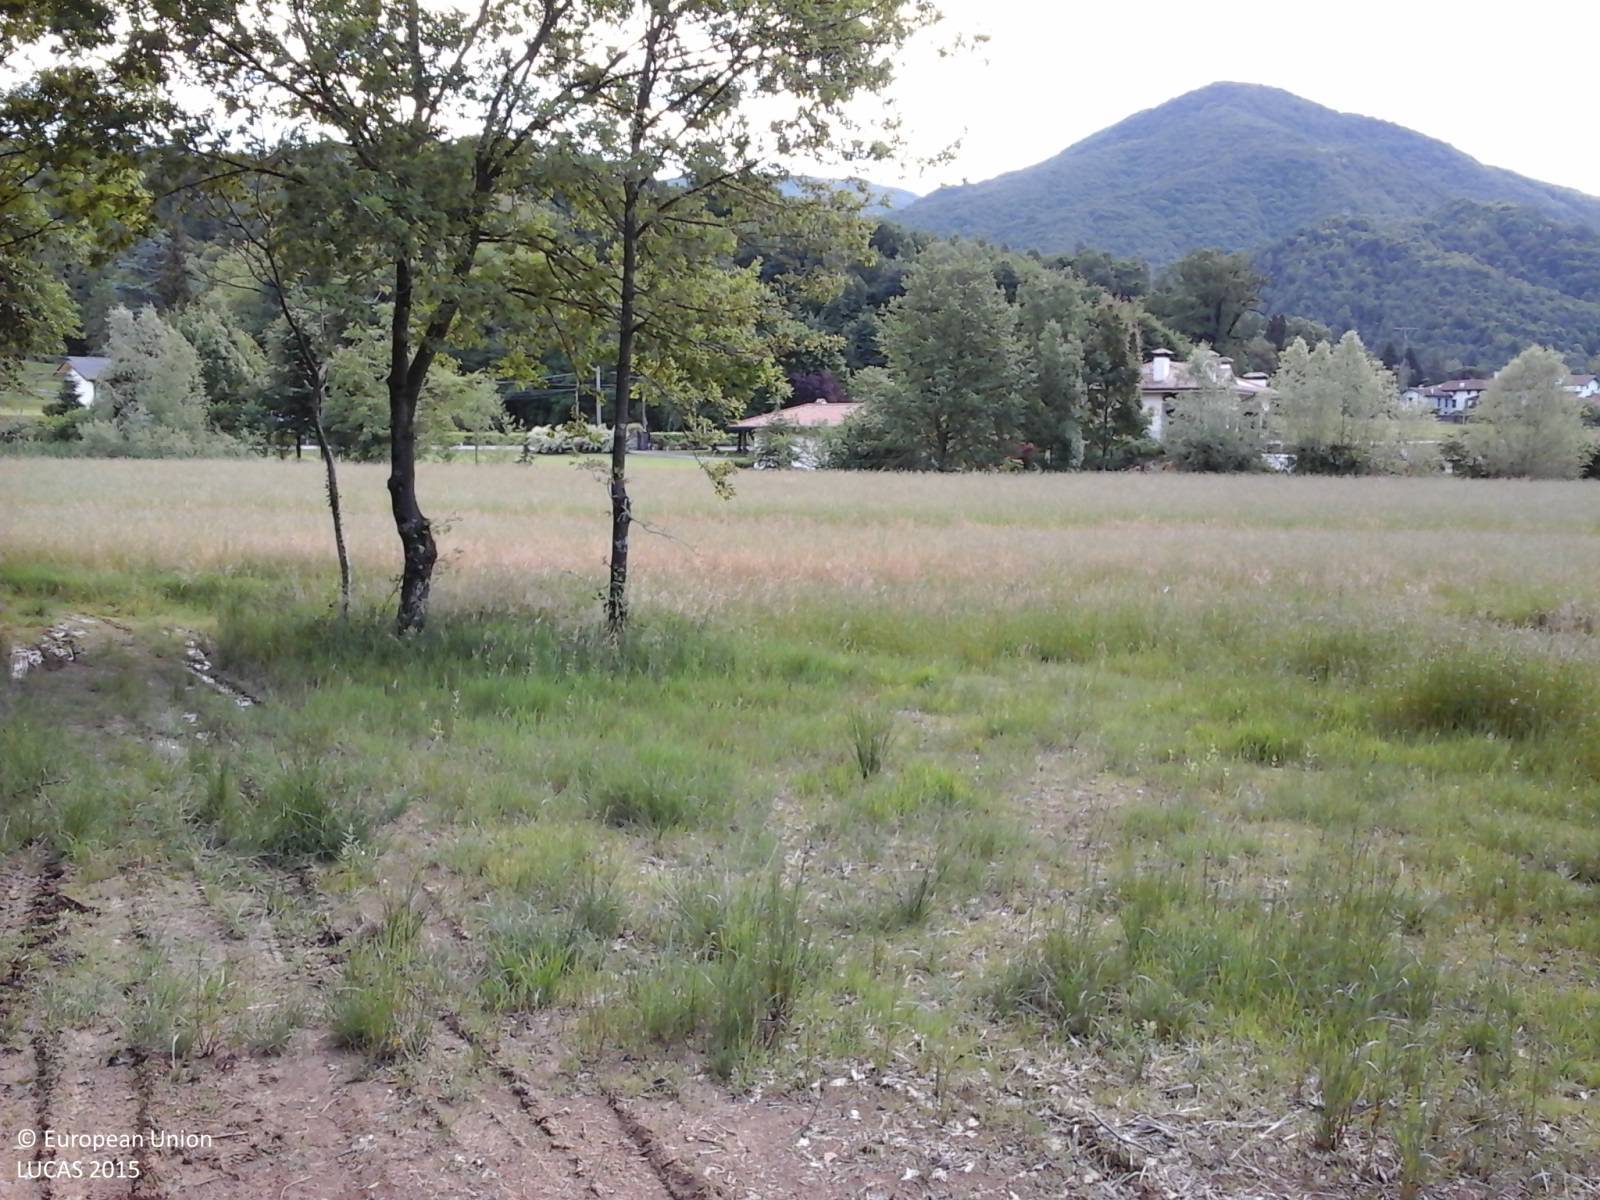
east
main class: Grassland
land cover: Spontaneously vegetated surfaces
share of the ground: < 10 %
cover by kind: unconsolidated bare surface 90 %, herbaceous plants 10 %
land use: Forestry
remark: Clear cut
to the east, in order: Spontaneously vegetated surfaces; Ditches and canals; Clovers; Ditches and canals; Clovers; Ditches and canals; Grass margins; Abandoned hedges; Grassland without tree/shrub cover; Artificial constructions in urban areas; Broadleaved woodland; Maize; Grassland without tree/shrub cover; Broadleaved woodland
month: June
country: IT
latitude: 46.1921
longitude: 13.3007
